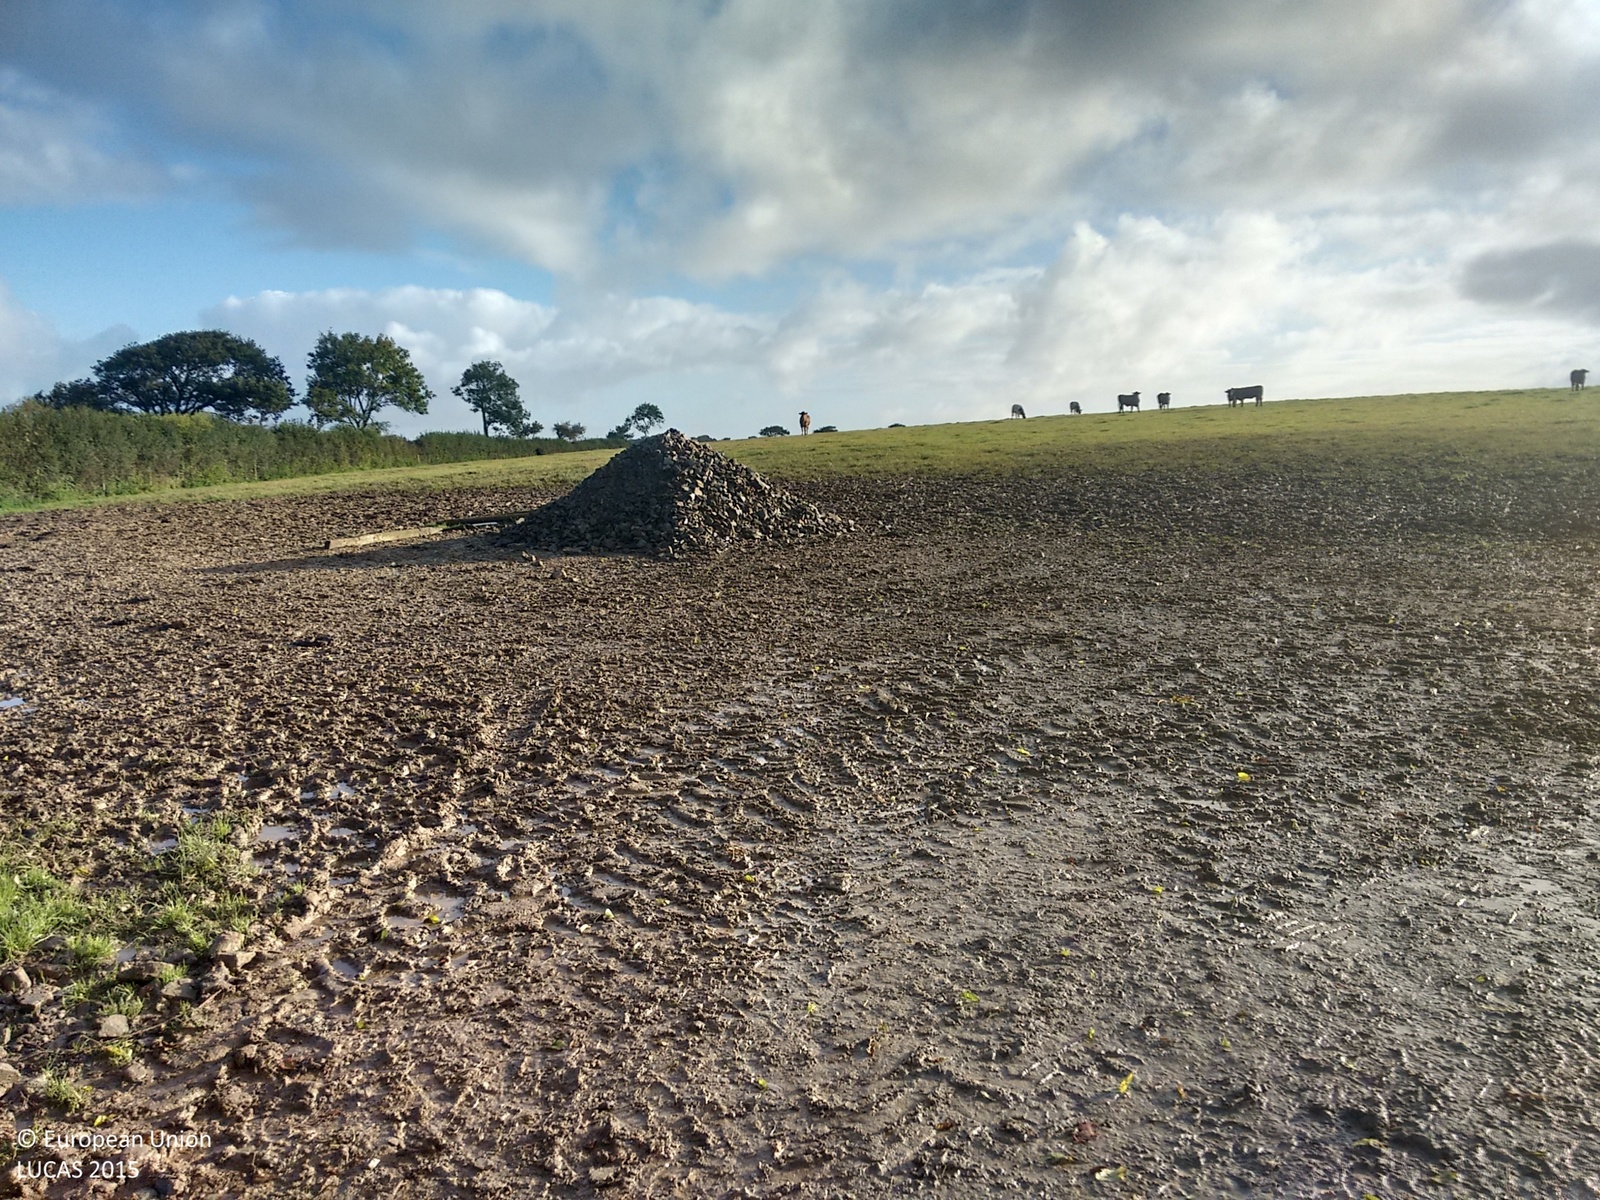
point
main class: Grassland
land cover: Grassland without tree/shrub cover
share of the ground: > 75 %
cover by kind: herbaceous plants 100 %
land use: Agriculture (excluding fallow land and kitchen gardens)
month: September
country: GB
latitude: 50.7013
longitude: -4.1569
